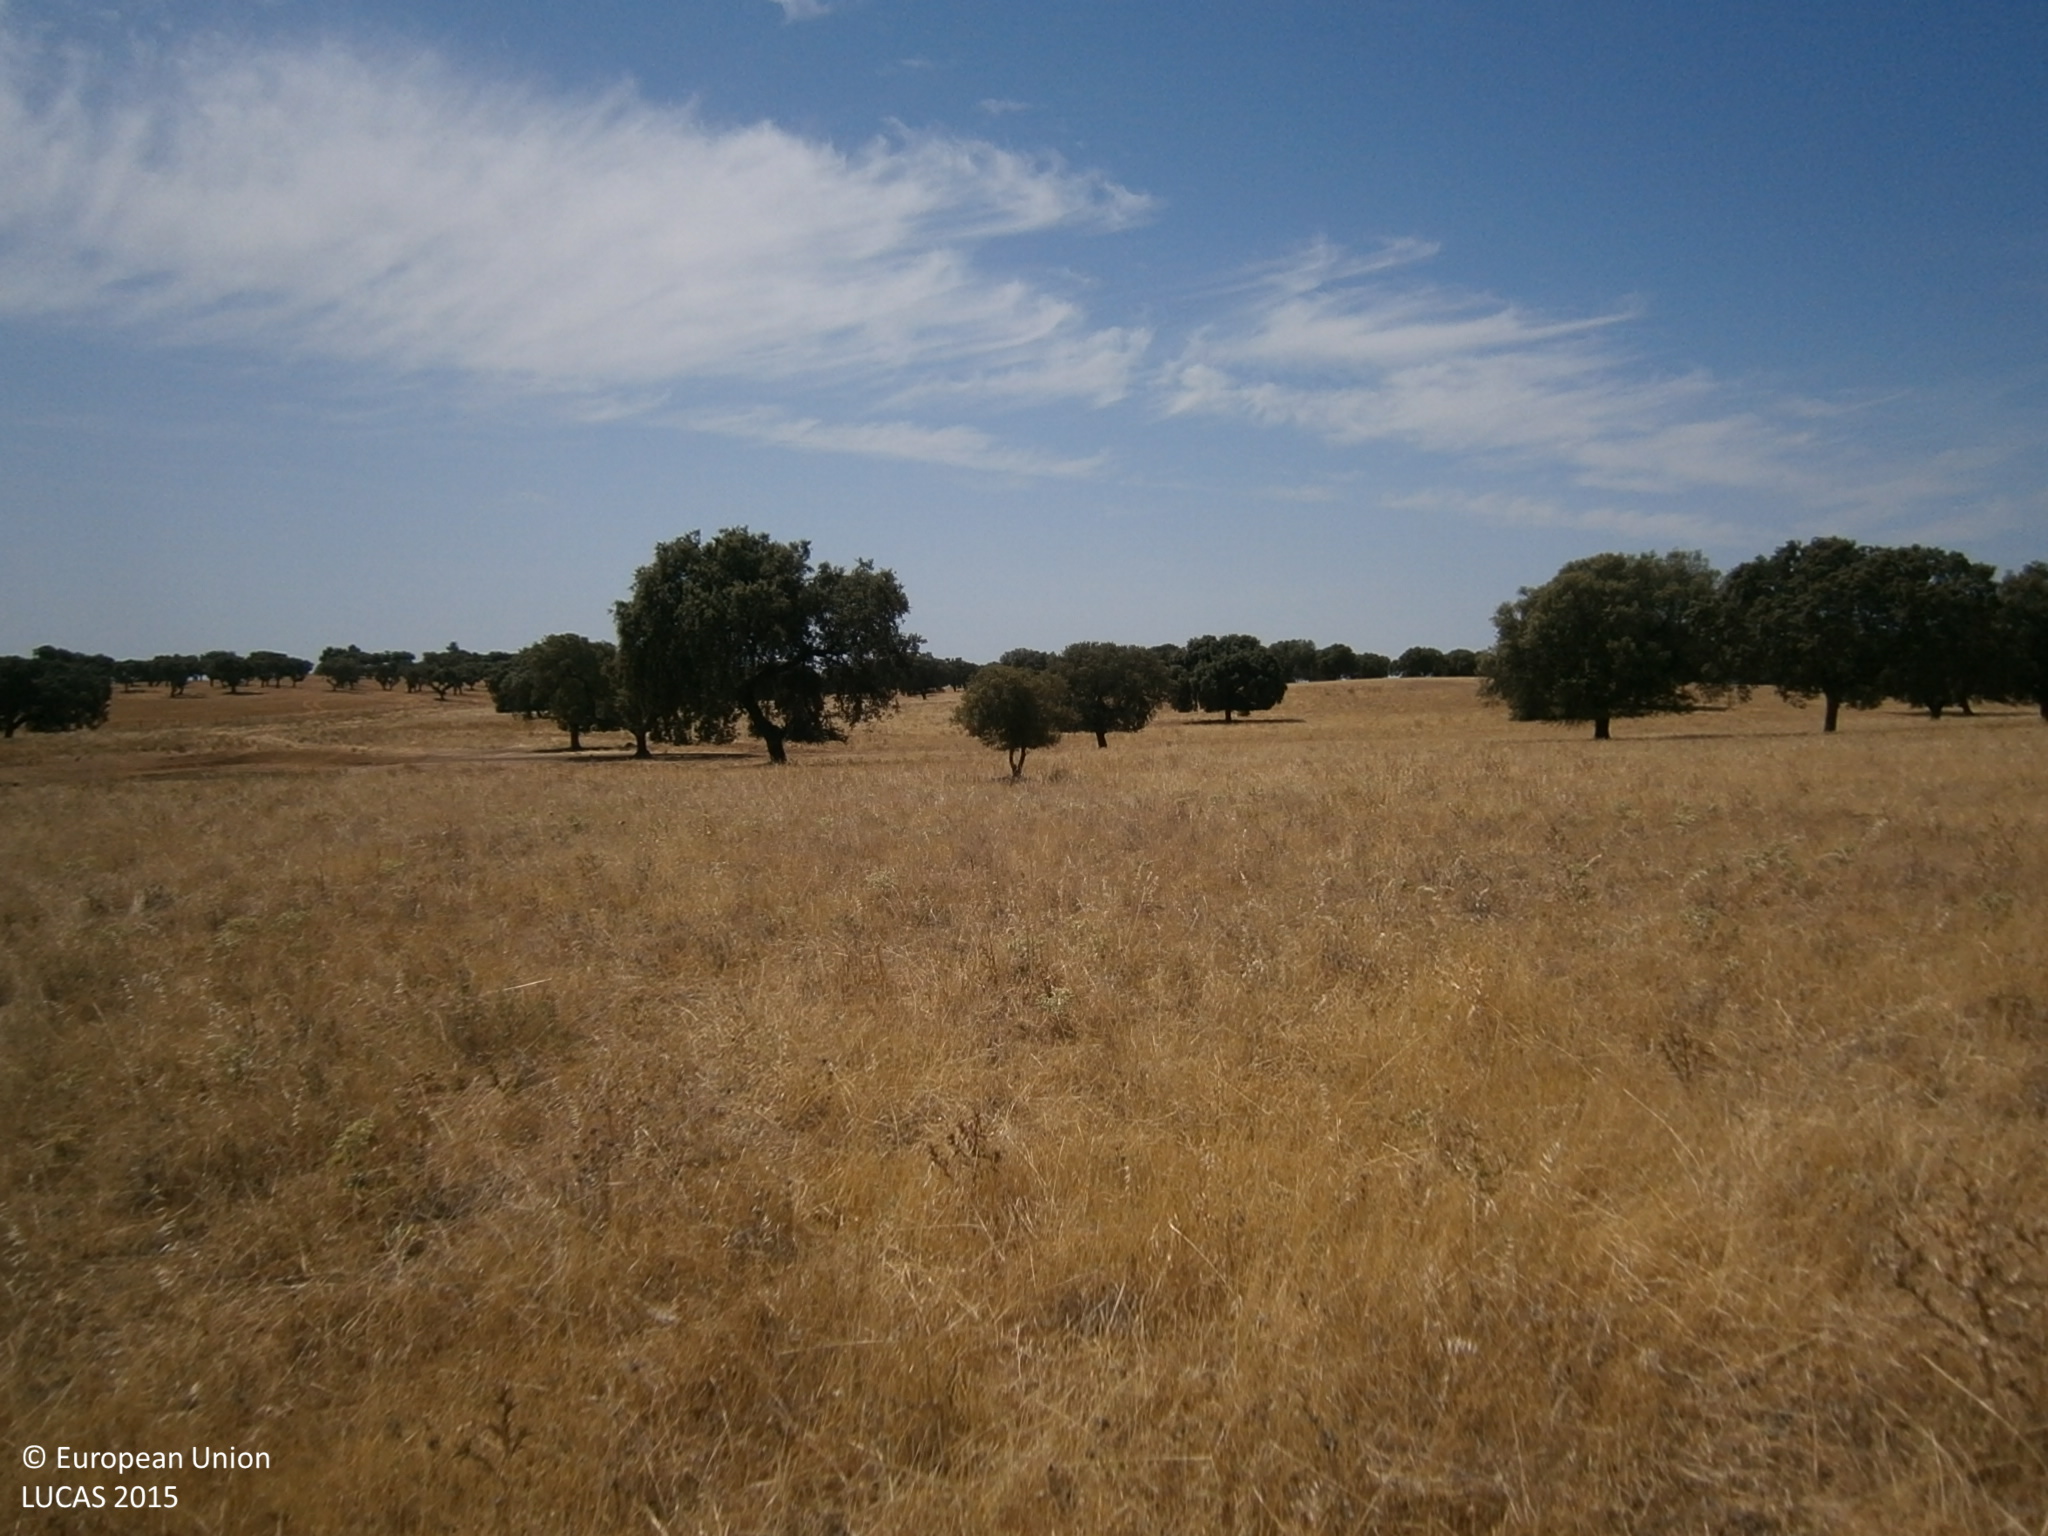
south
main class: Grassland
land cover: Grassland with sparse tree/shrub cover
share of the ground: > 75 %
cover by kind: herbaceous plants 90 %, broadleaved forest trees 5 %, unconsolidated bare surface 5 %
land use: Agriculture (excluding fallow land and kitchen gardens)
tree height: > 5 m
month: July
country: ES
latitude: 38.9878
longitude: -6.8200
